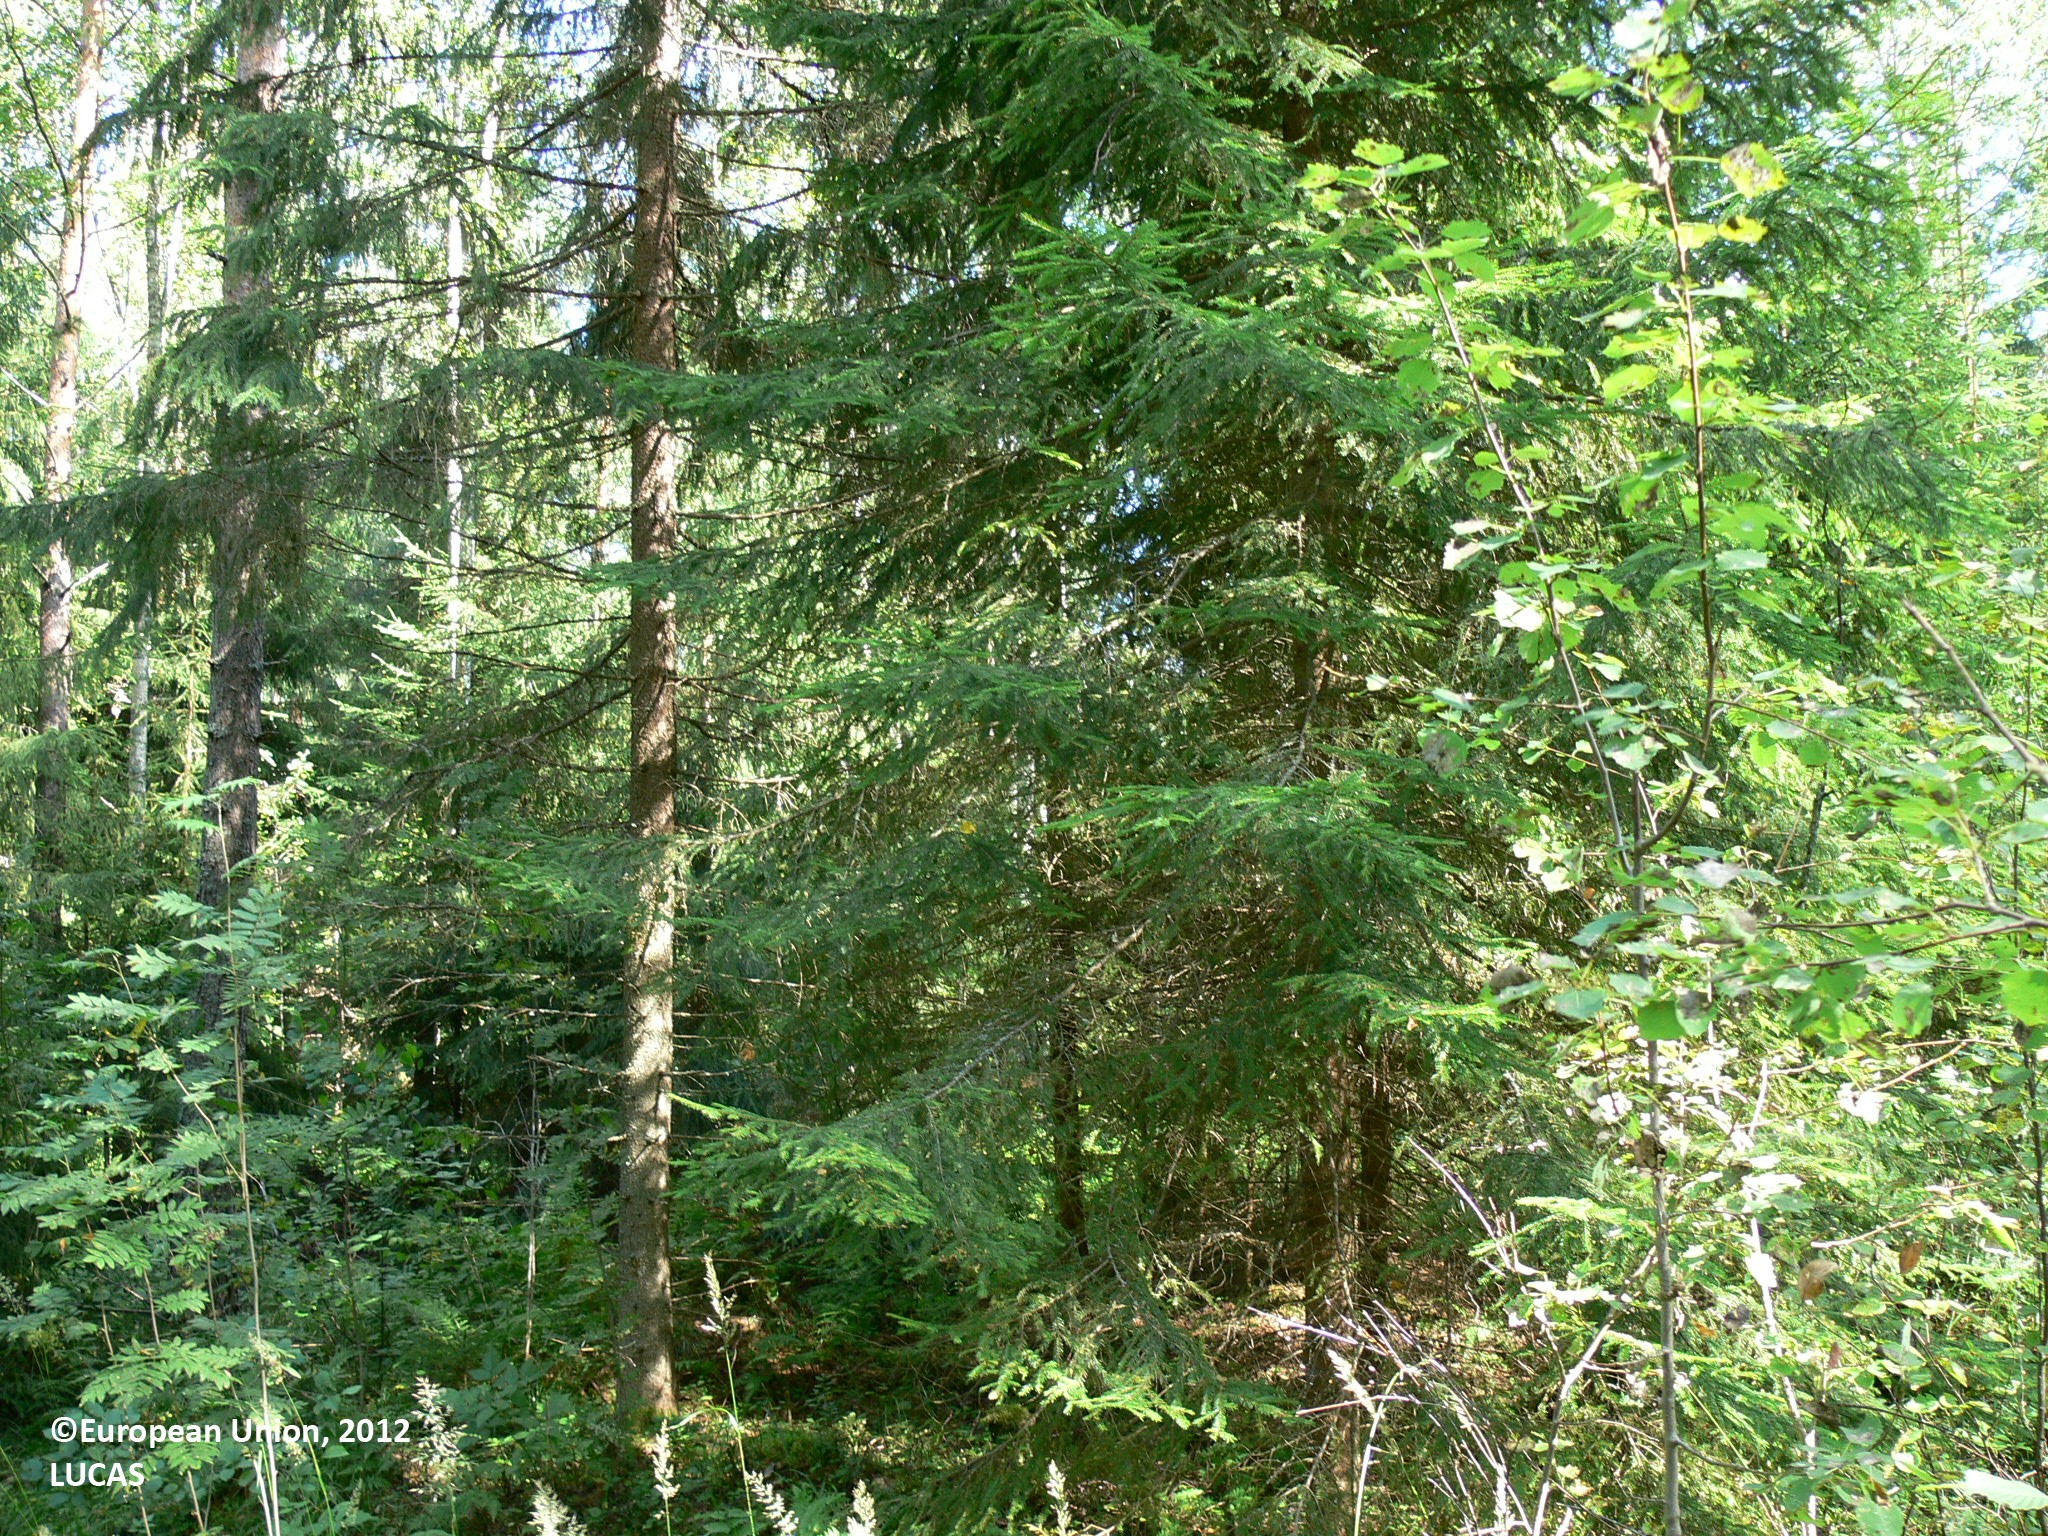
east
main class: Woodland
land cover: Other mixed woodland
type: boreal forest
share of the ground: > 75 %
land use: Forestry
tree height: > 5 m
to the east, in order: Other mixed woodland; Ditches and canals; Other mixed woodland; Spruce dominated mixed woodland; Ditches and canals; Spruce dominated coniferous woodland; Ditches and canals; Paved roads, cycling and walking lanes; Grass margins; Ditches and canals; Grass margins; Temporary grasslands; Grass margins; Ditches and canals; Grass margins; Other mixed woodland
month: August
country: FI
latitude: 61.8058
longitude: 29.1891
